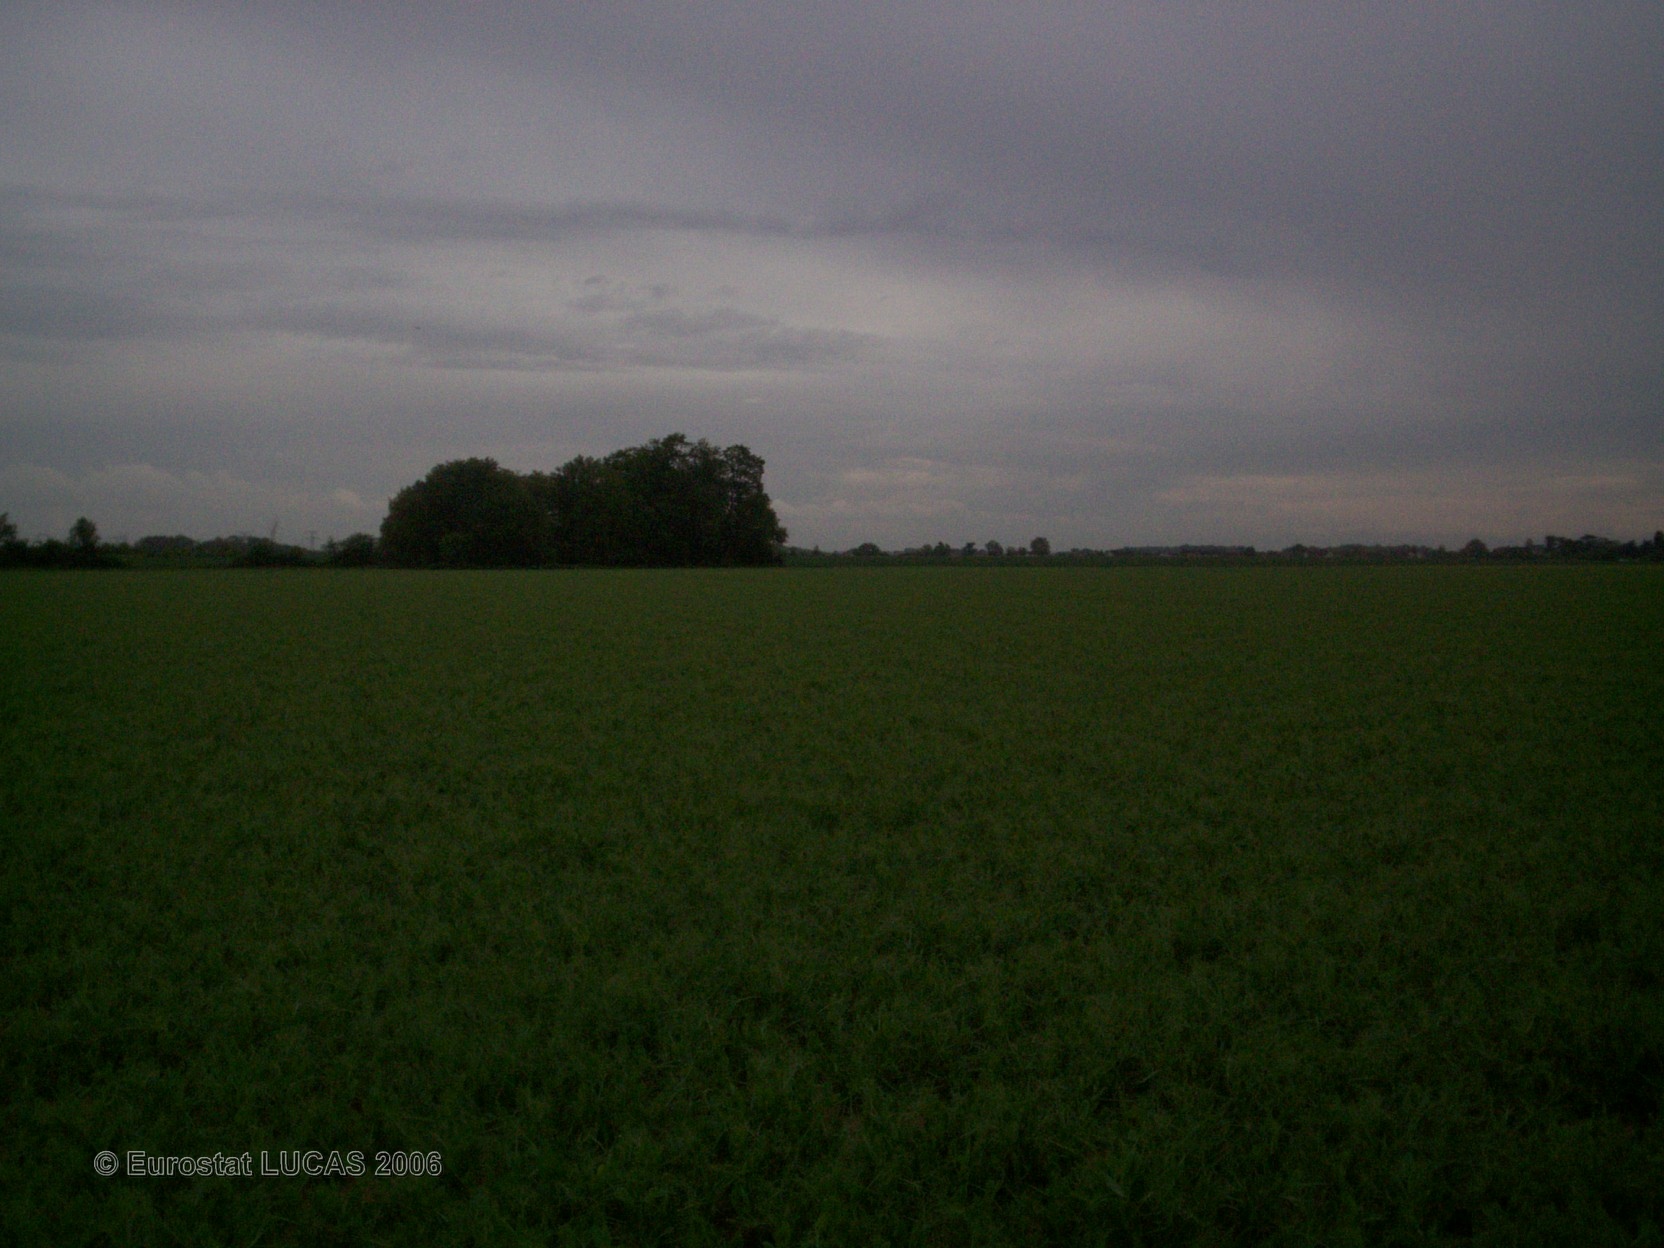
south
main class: Cropland
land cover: Dry pulses
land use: Agriculture (excluding fallow land and kitchen gardens)
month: May
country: FR
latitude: 48.6695
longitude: 2.7254
